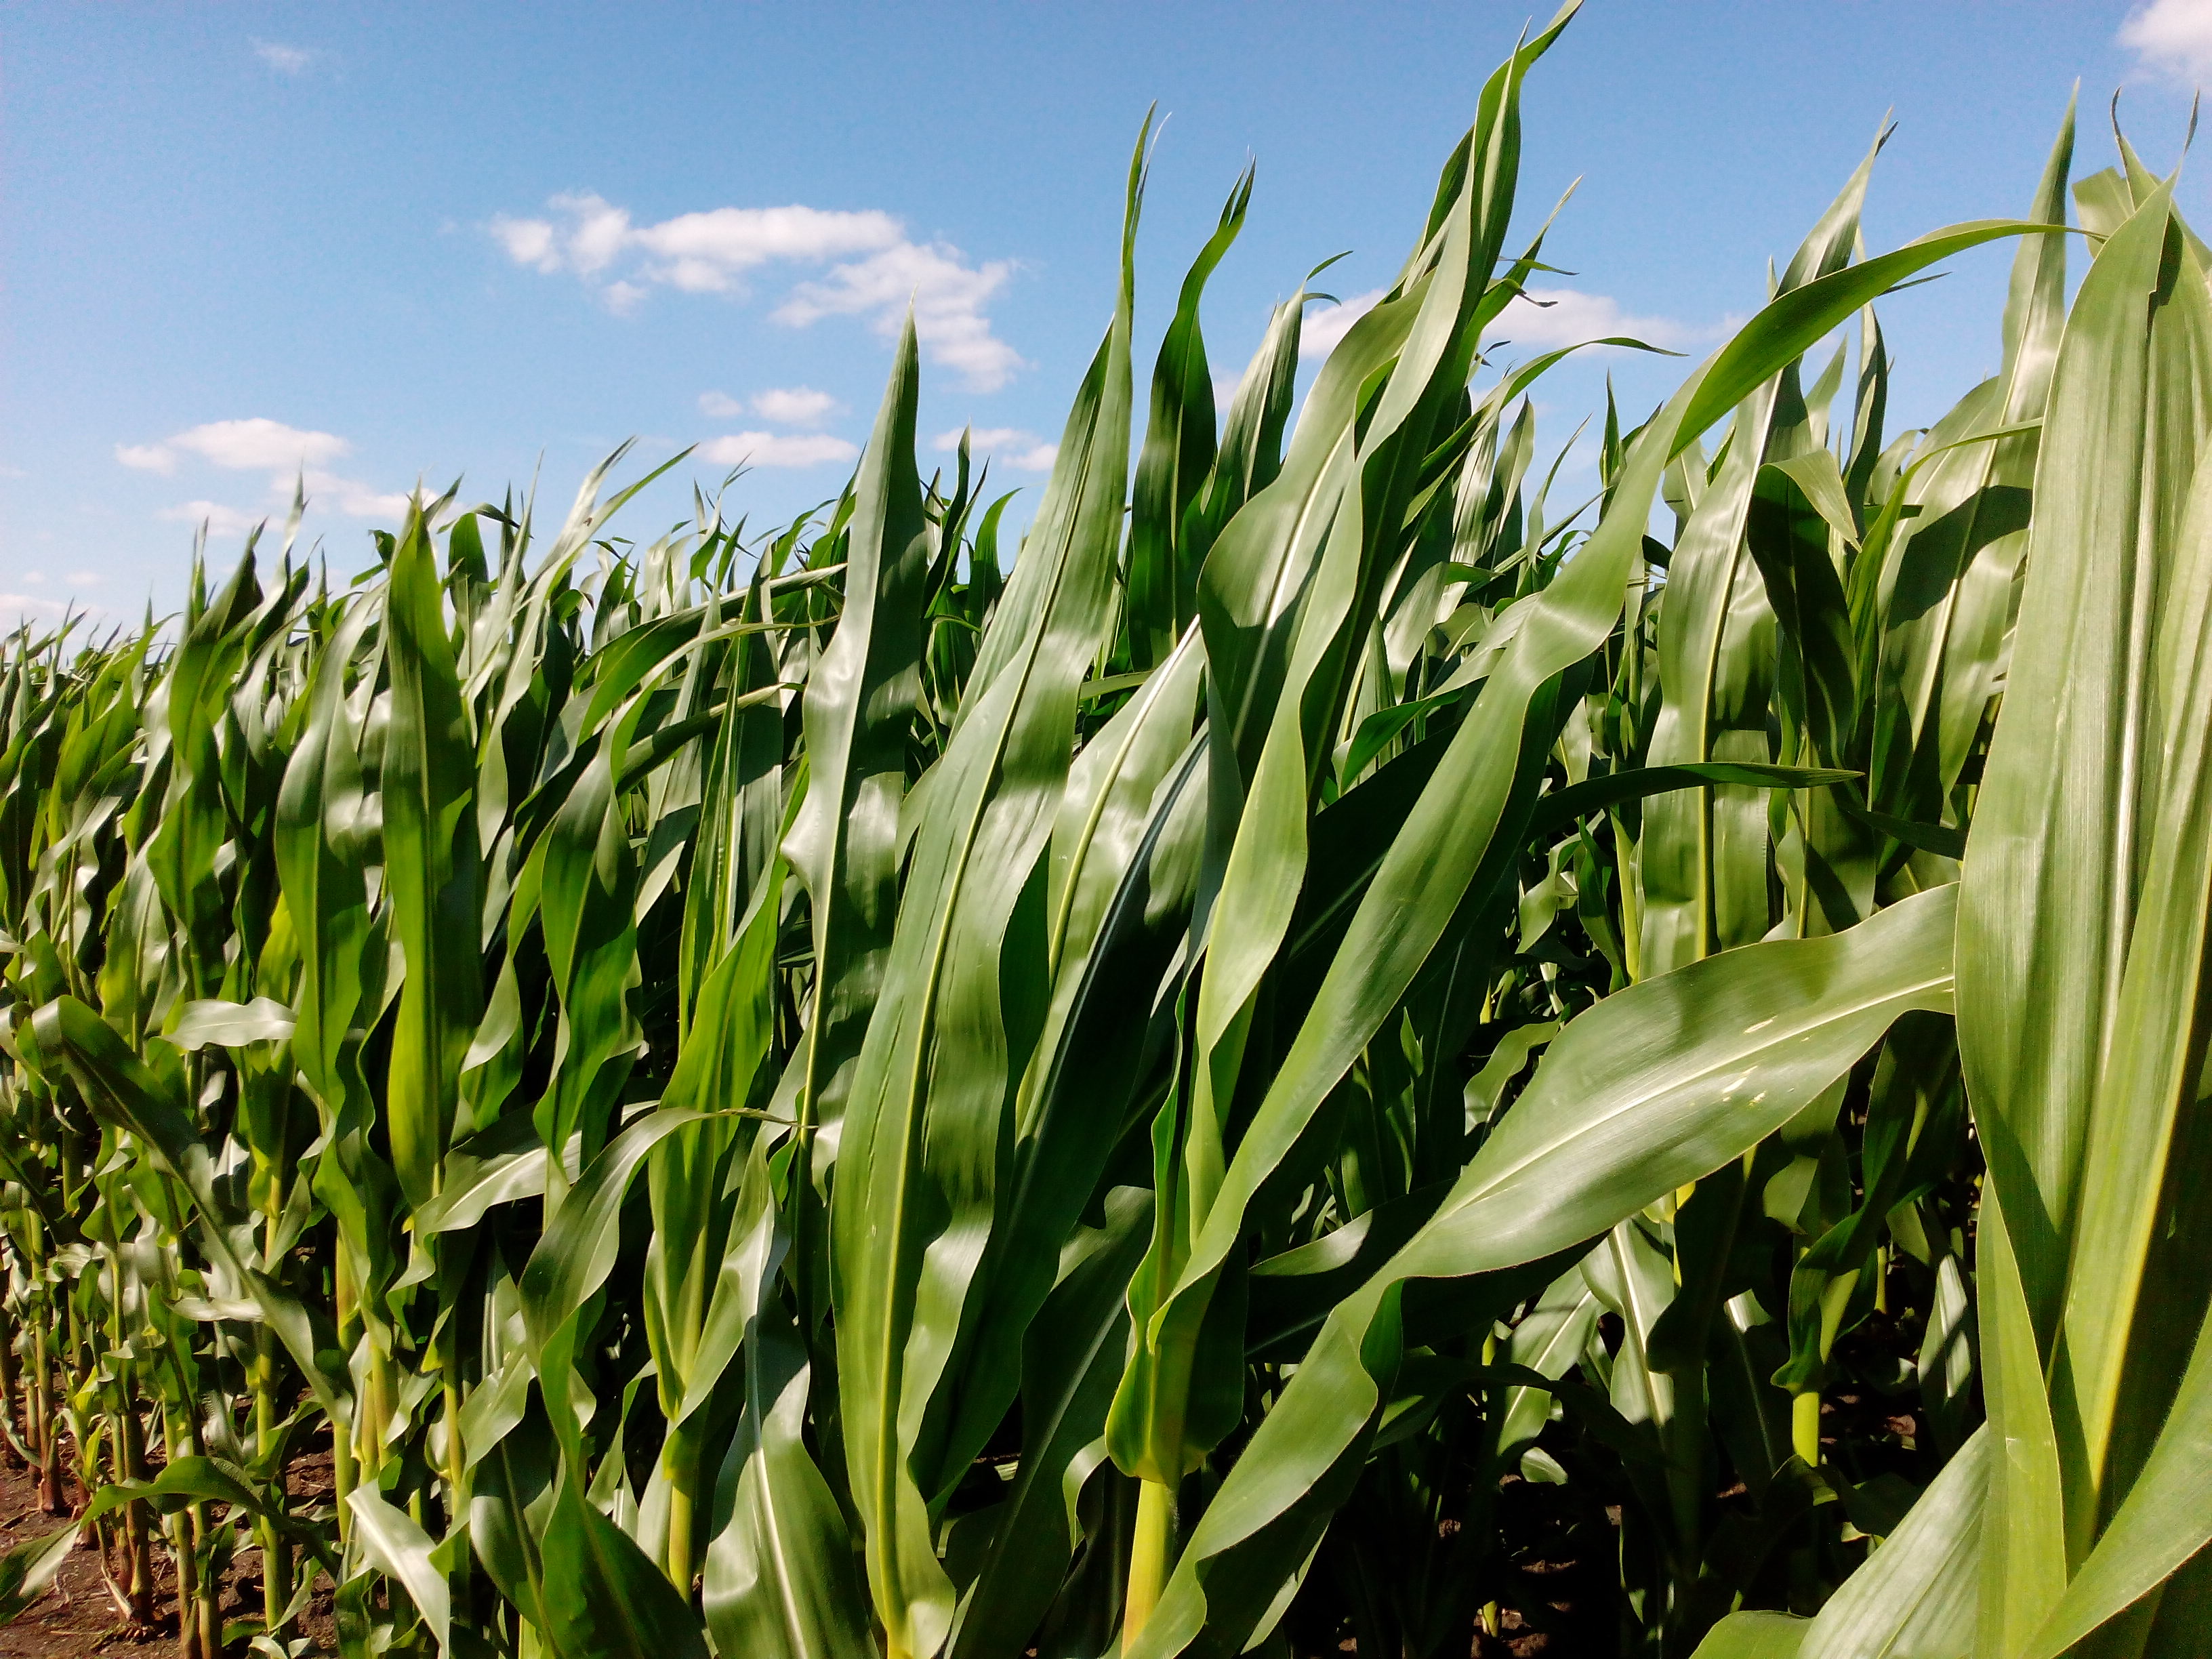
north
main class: Cropland
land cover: Maize
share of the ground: > 75 %
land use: Agriculture (excluding fallow land and kitchen gardens)
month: July
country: DE
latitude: 51.0963
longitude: 11.0707
